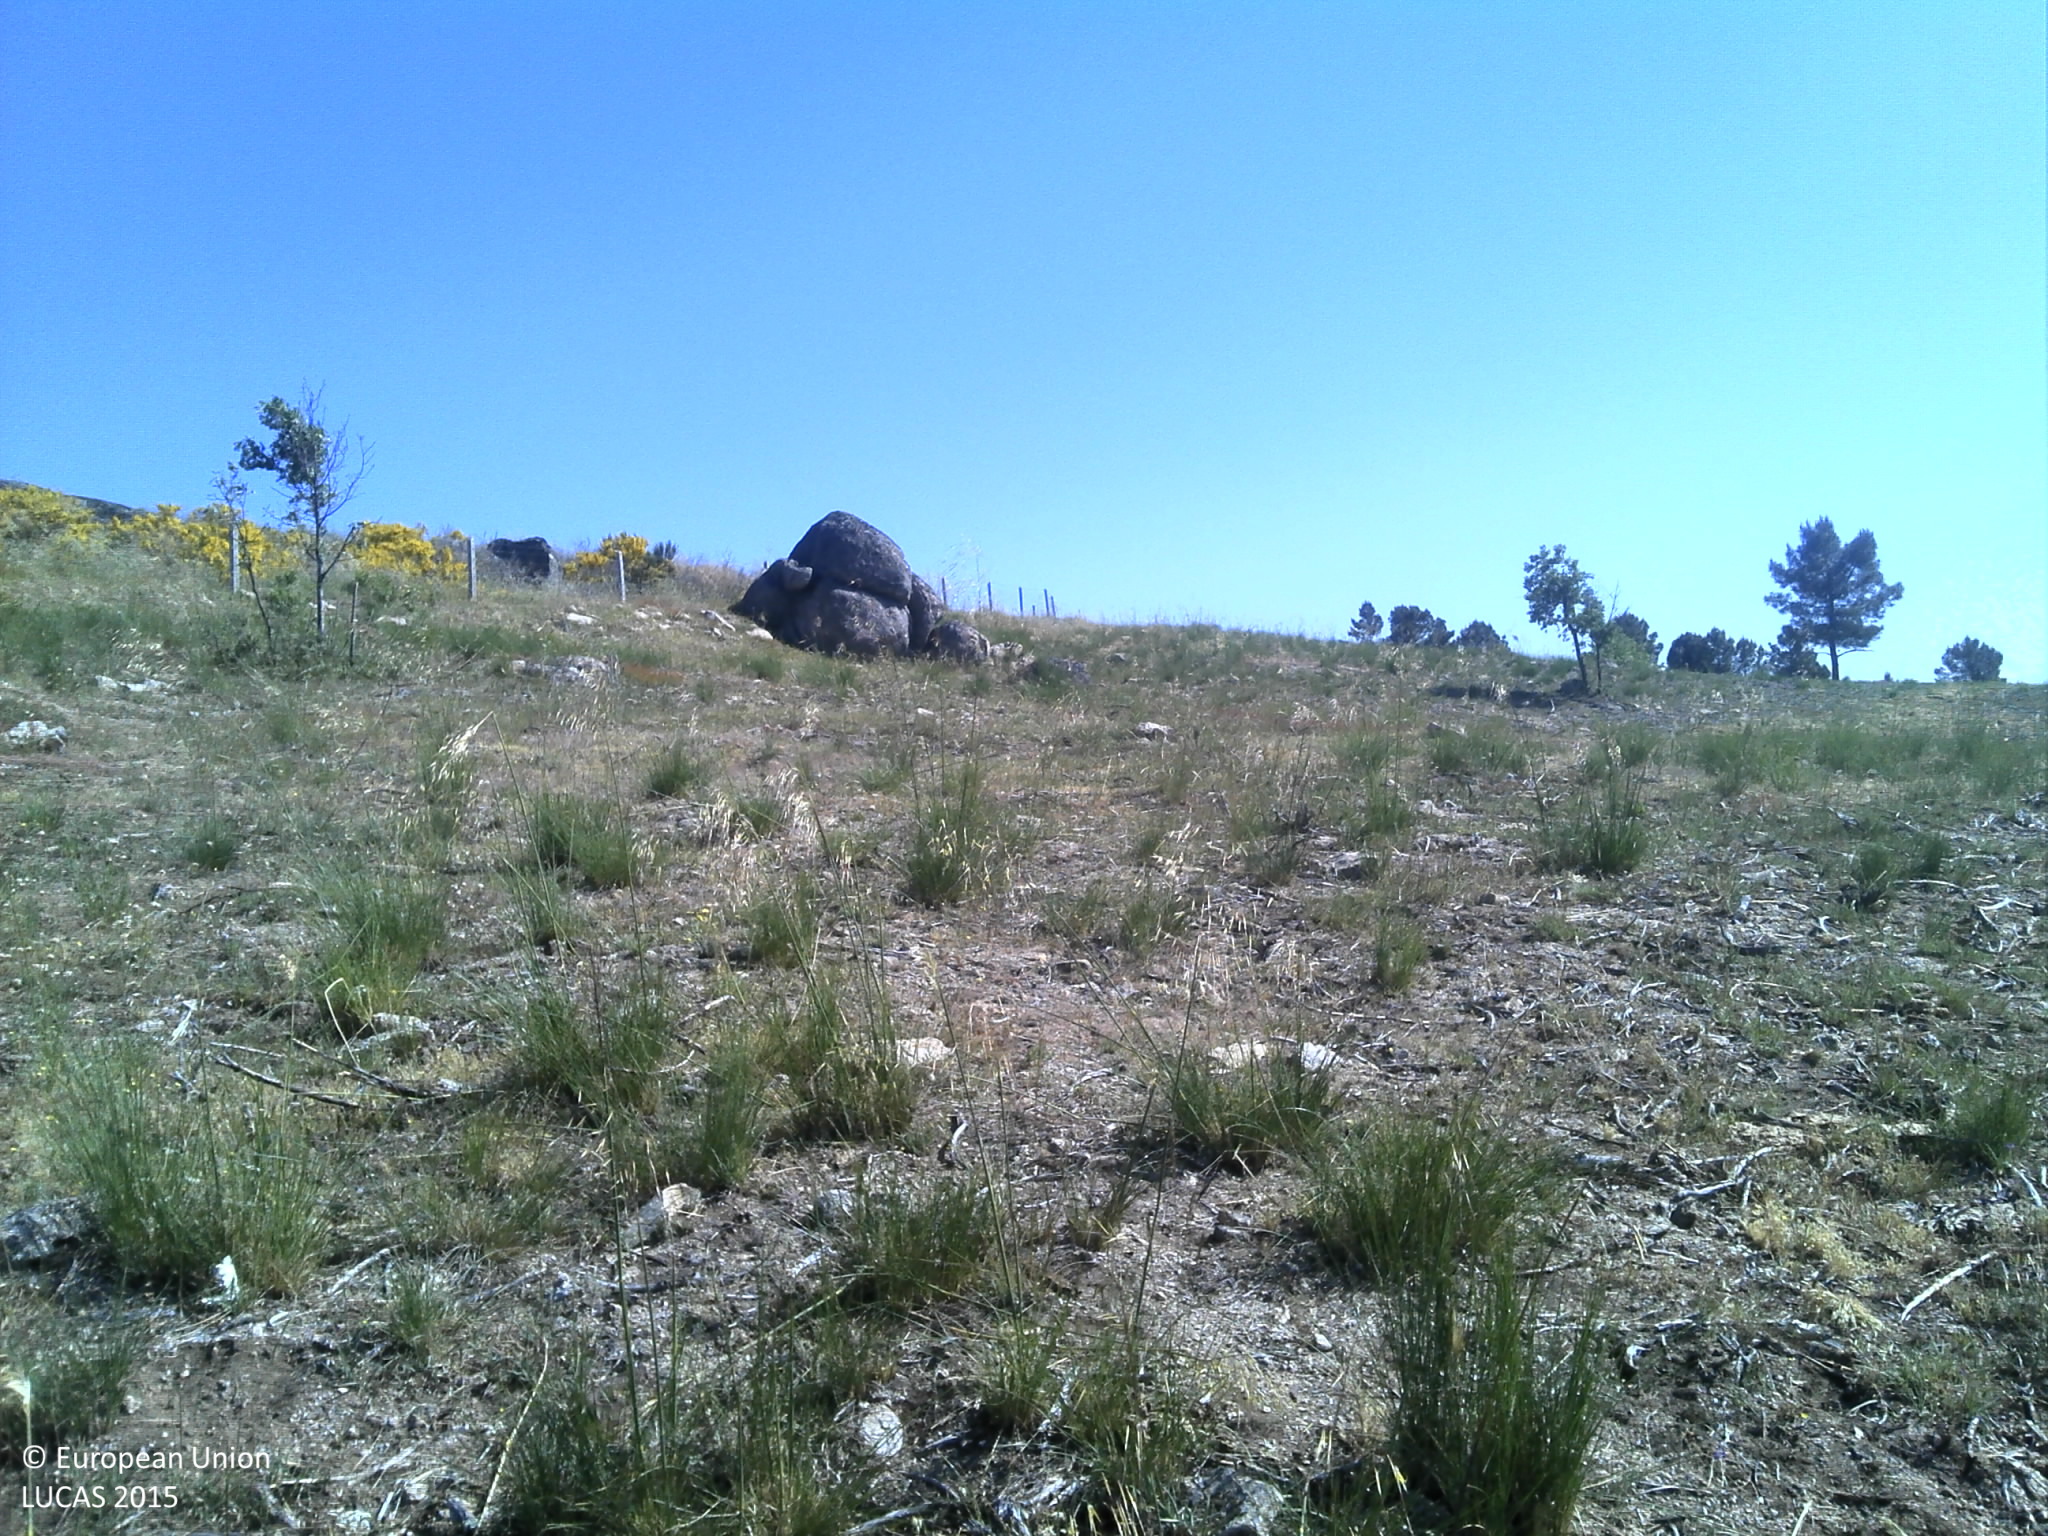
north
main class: Grassland
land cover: Grassland without tree/shrub cover
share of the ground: 10 - 25 %
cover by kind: unconsolidated bare surface 65 %, herbaceous plants 25 %, shrubs 5 %
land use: Agriculture (excluding fallow land and kitchen gardens)
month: May
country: PT
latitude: 40.5459
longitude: -7.2869
